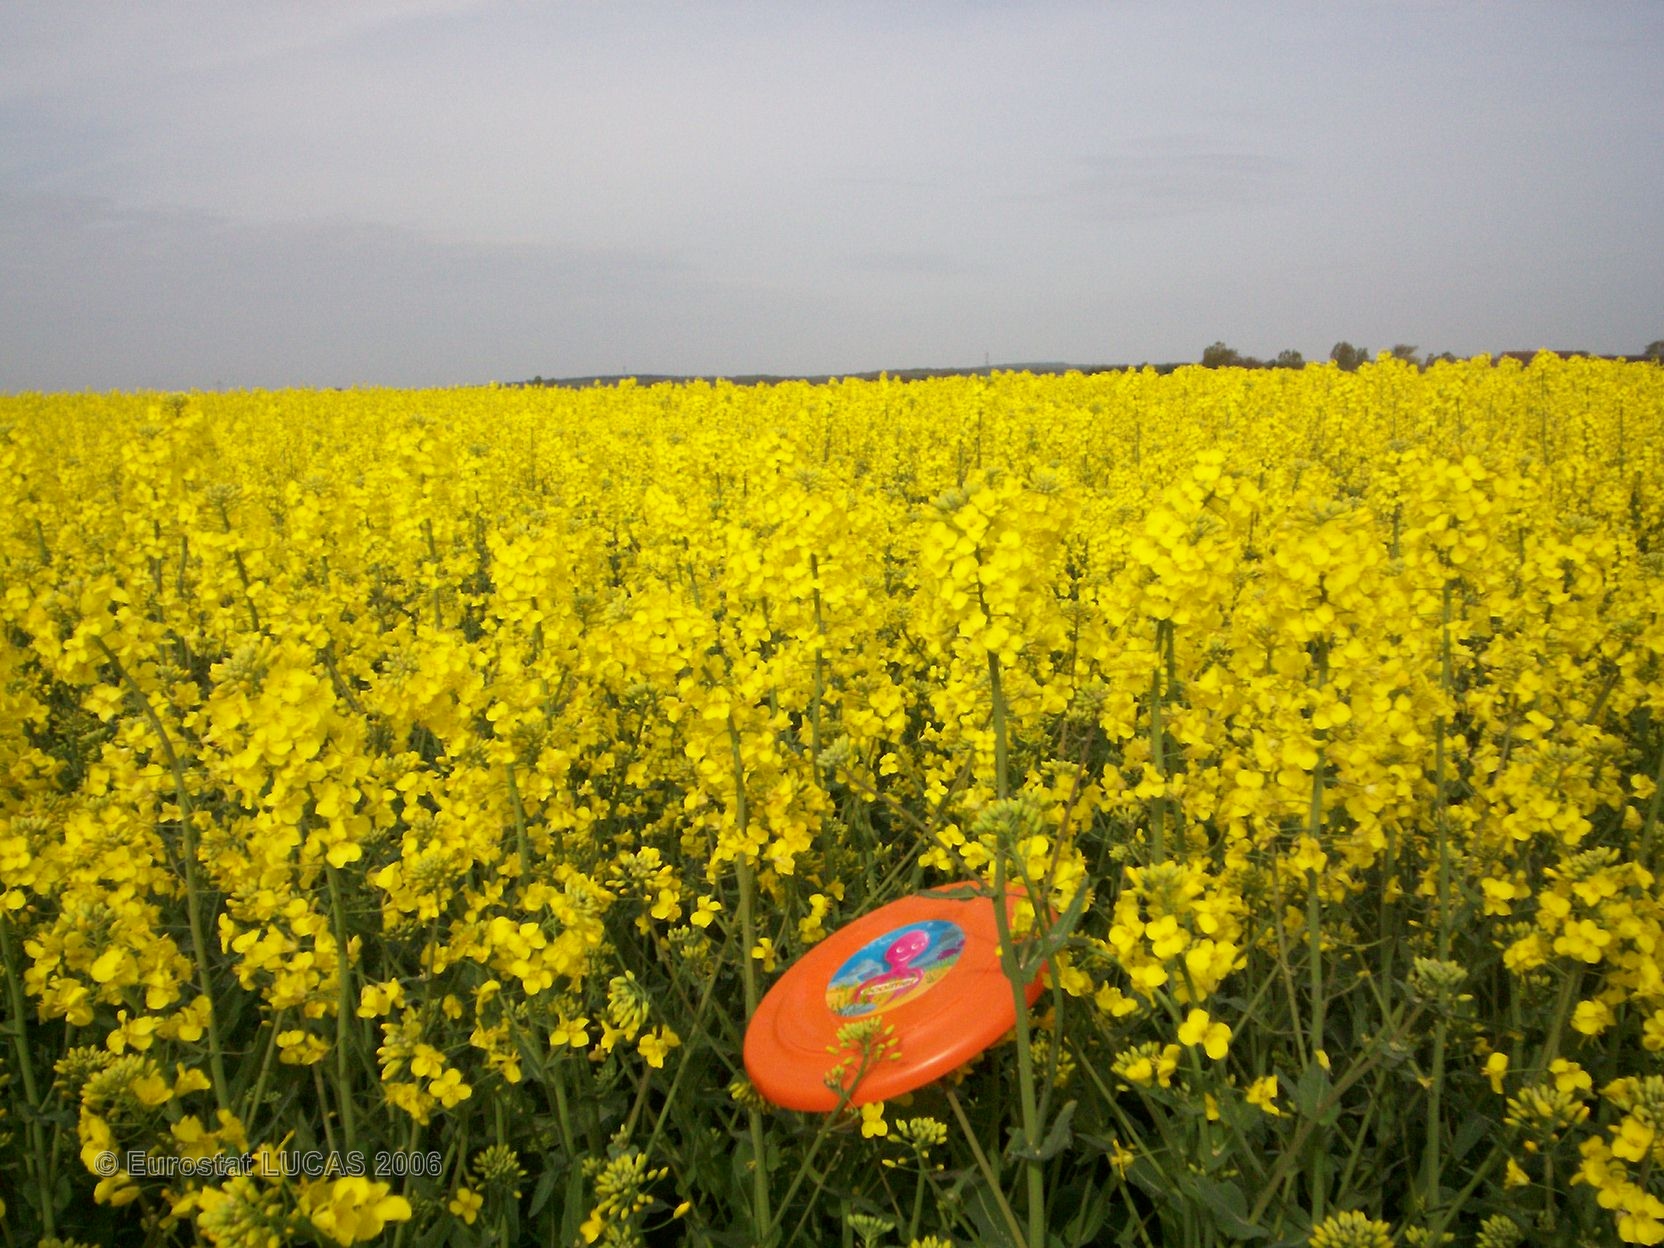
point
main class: Cropland
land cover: Rape and turnip rape
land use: Agriculture (excluding fallow land and kitchen gardens)
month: May
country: FR
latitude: 47.2998
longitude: 3.0518
